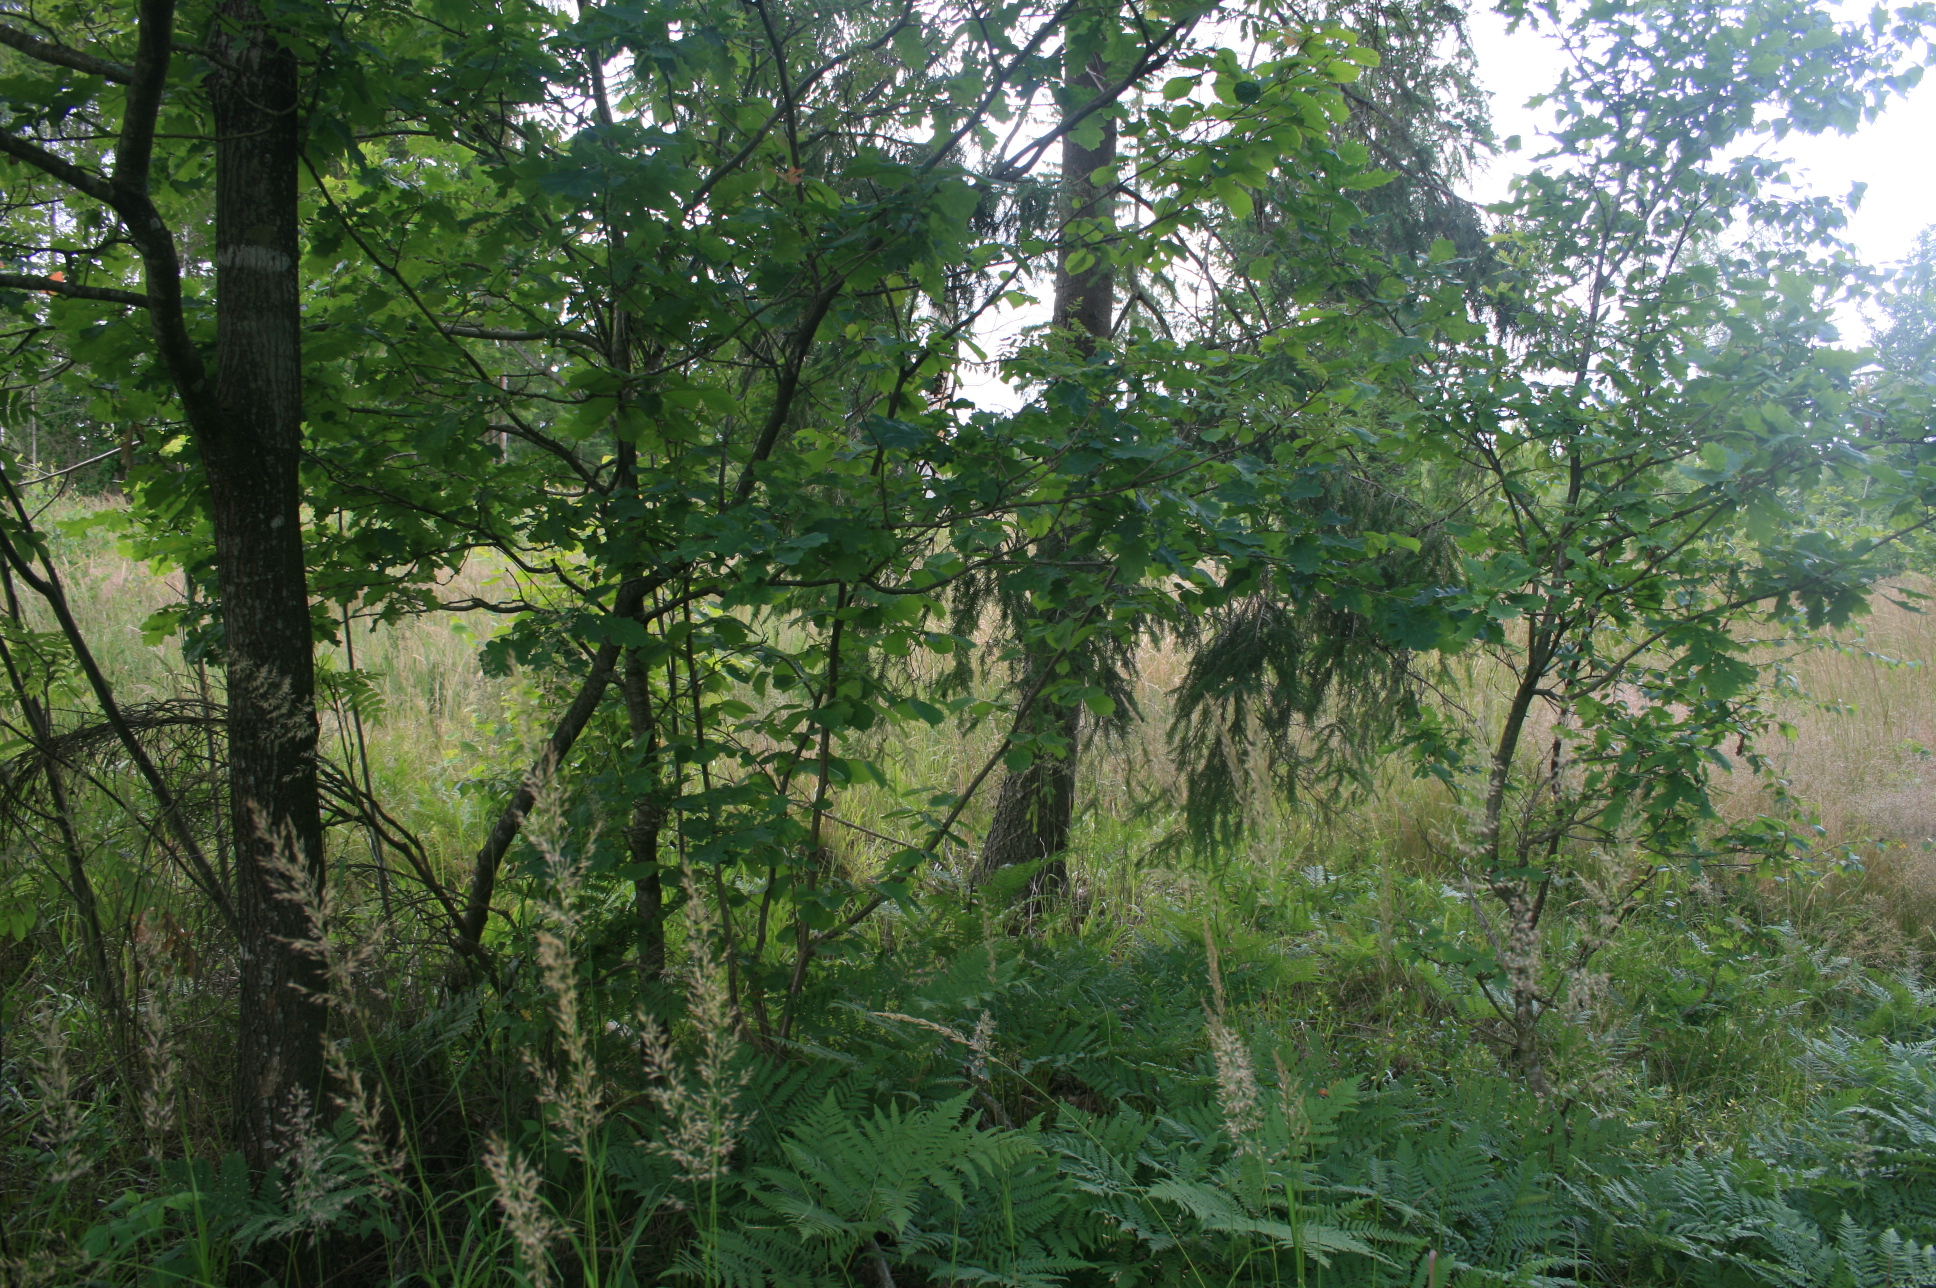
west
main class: Woodland
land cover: Spruce dominated mixed woodland
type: hemiboreal forest and nemoral coniferous forest and mixed broadleaved-coniferous forest
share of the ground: 50 - 75 %
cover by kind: coniferous forest trees 45 %, herbaceous plants 30 %, broadleaved forest trees 25 %
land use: Forestry
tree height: > 5 m
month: July
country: LT
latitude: 55.8268
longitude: 21.3608
